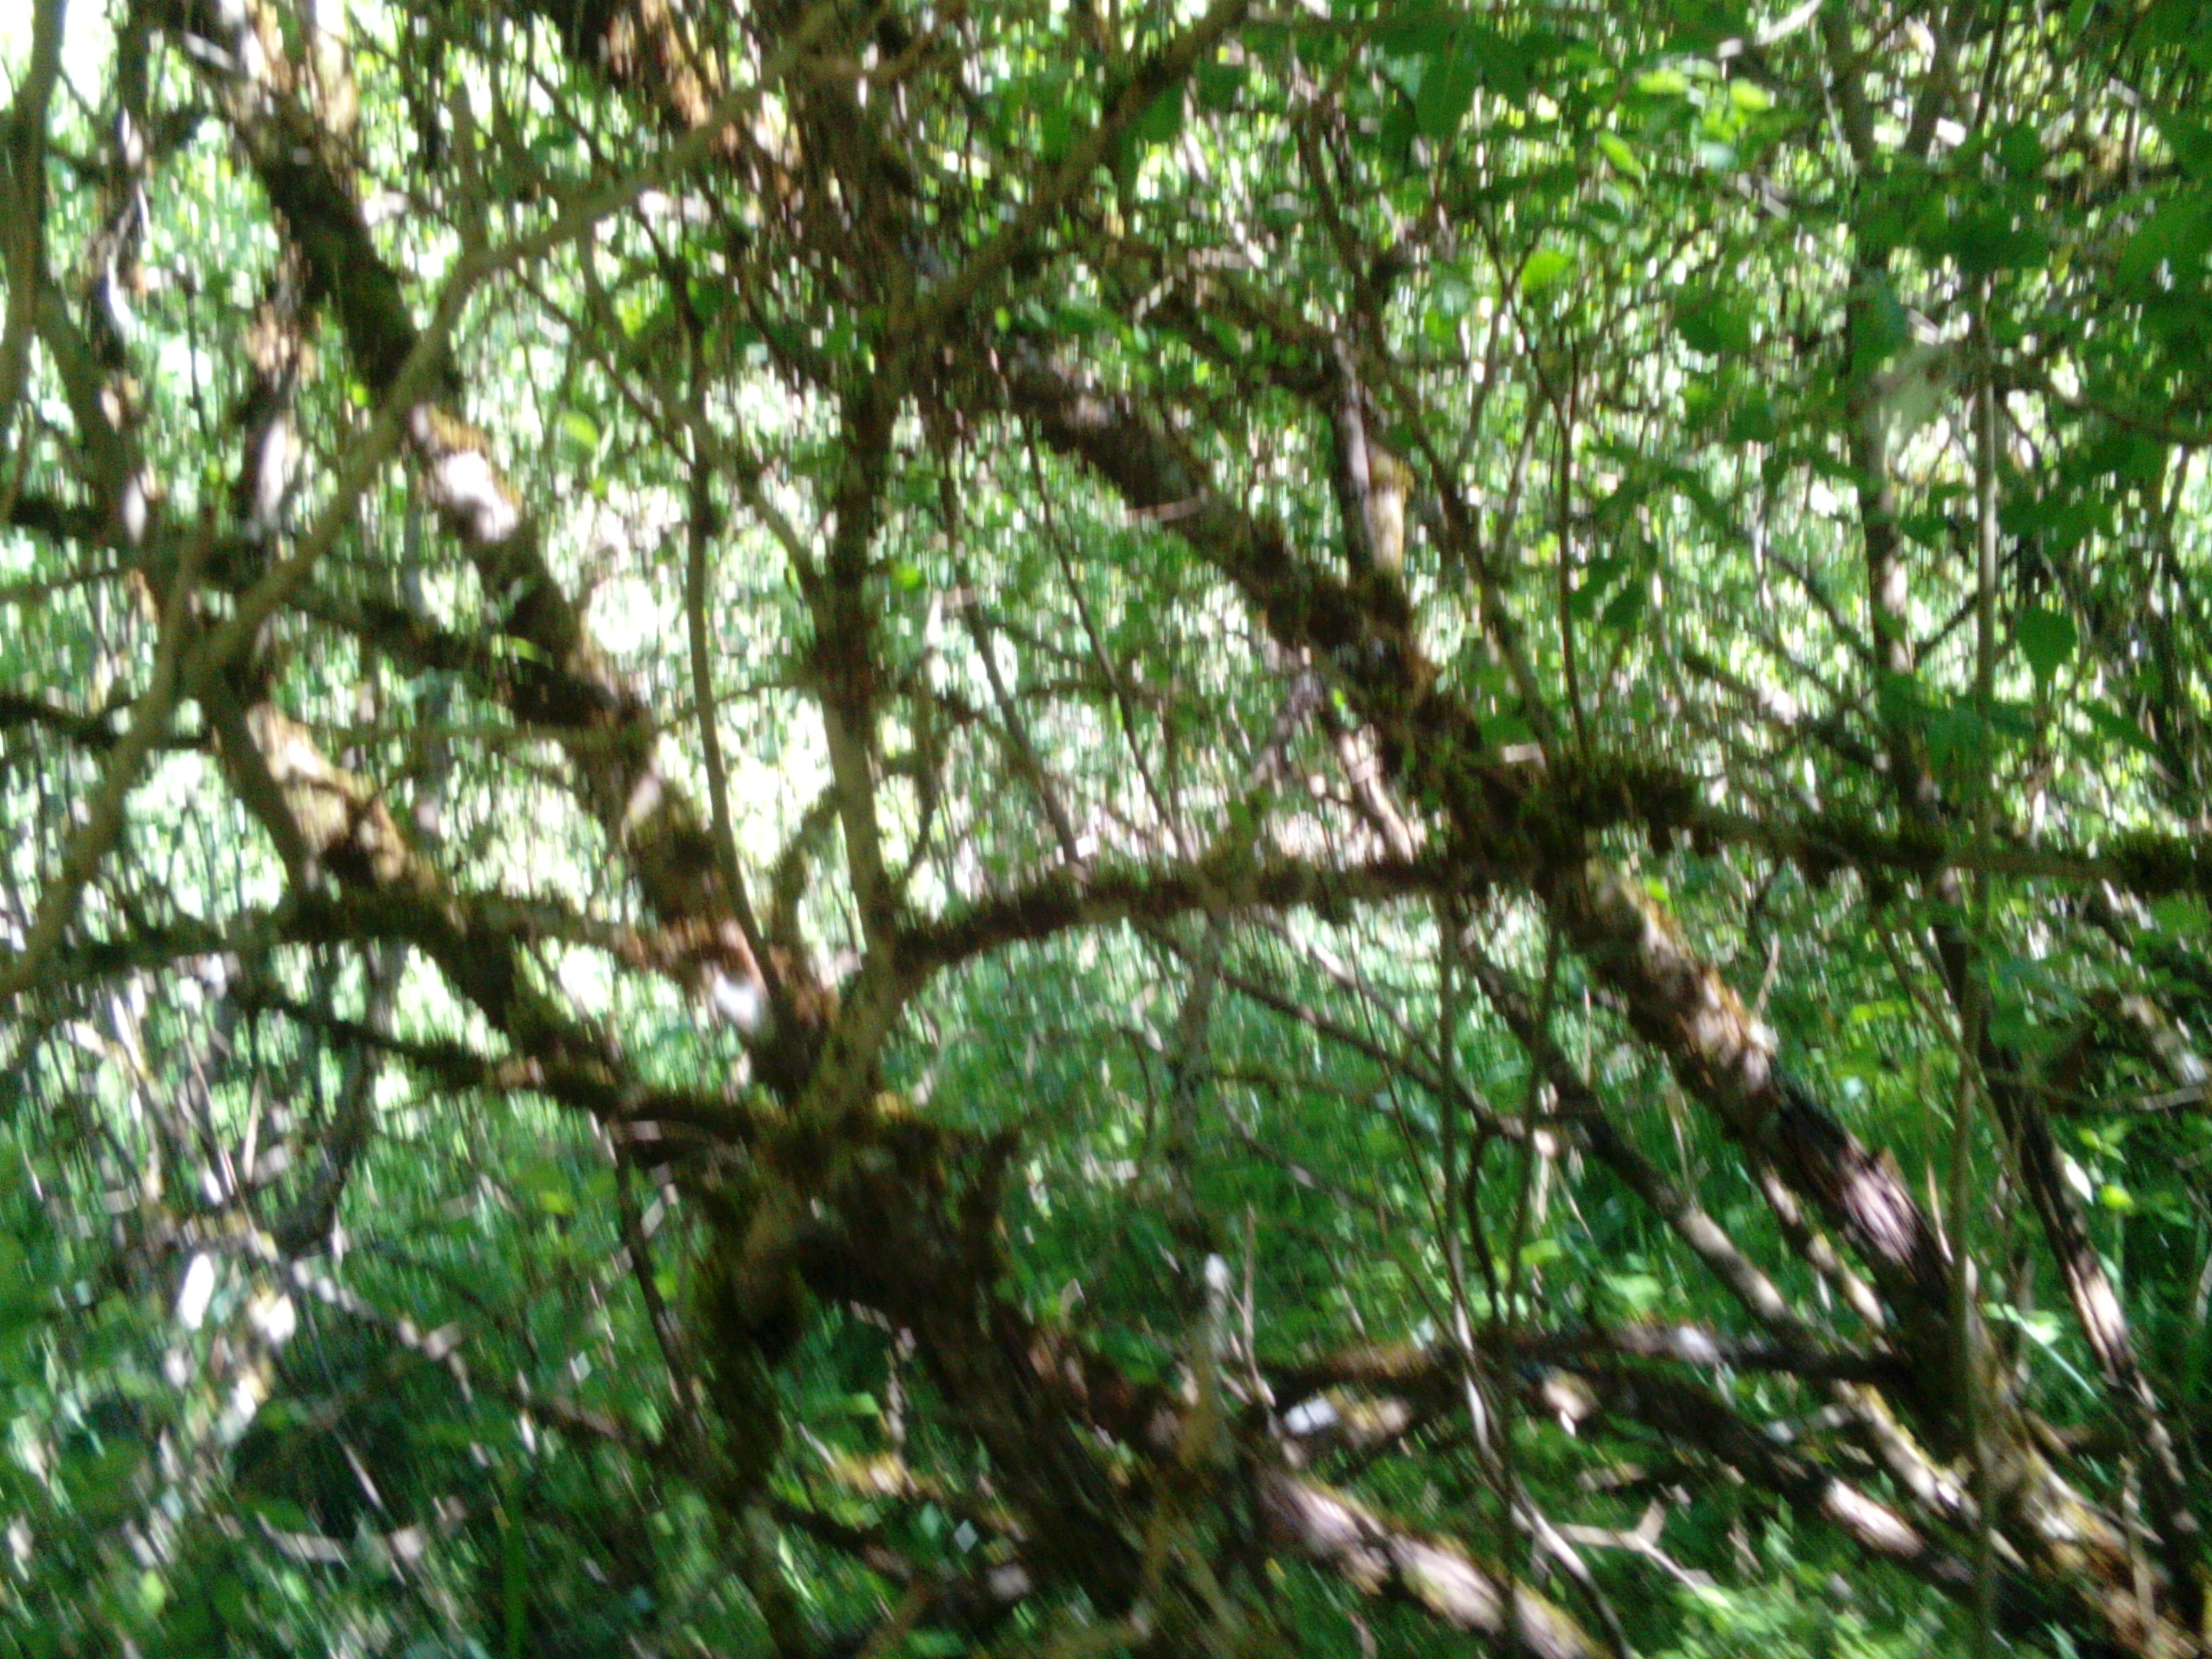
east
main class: Woodland
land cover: Spruce dominated mixed woodland
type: hemiboreal forest and nemoral coniferous forest and mixed broadleaved-coniferous forest
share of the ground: > 75 %
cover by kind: broadleaved forest trees 55 %, coniferous forest trees 25 %, shrubs 10 %, herbaceous plants 10 %
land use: Forestry
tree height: > 5 m
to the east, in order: Spruce dominated mixed woodland
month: June
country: LV
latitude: 56.5940
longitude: 22.1185
